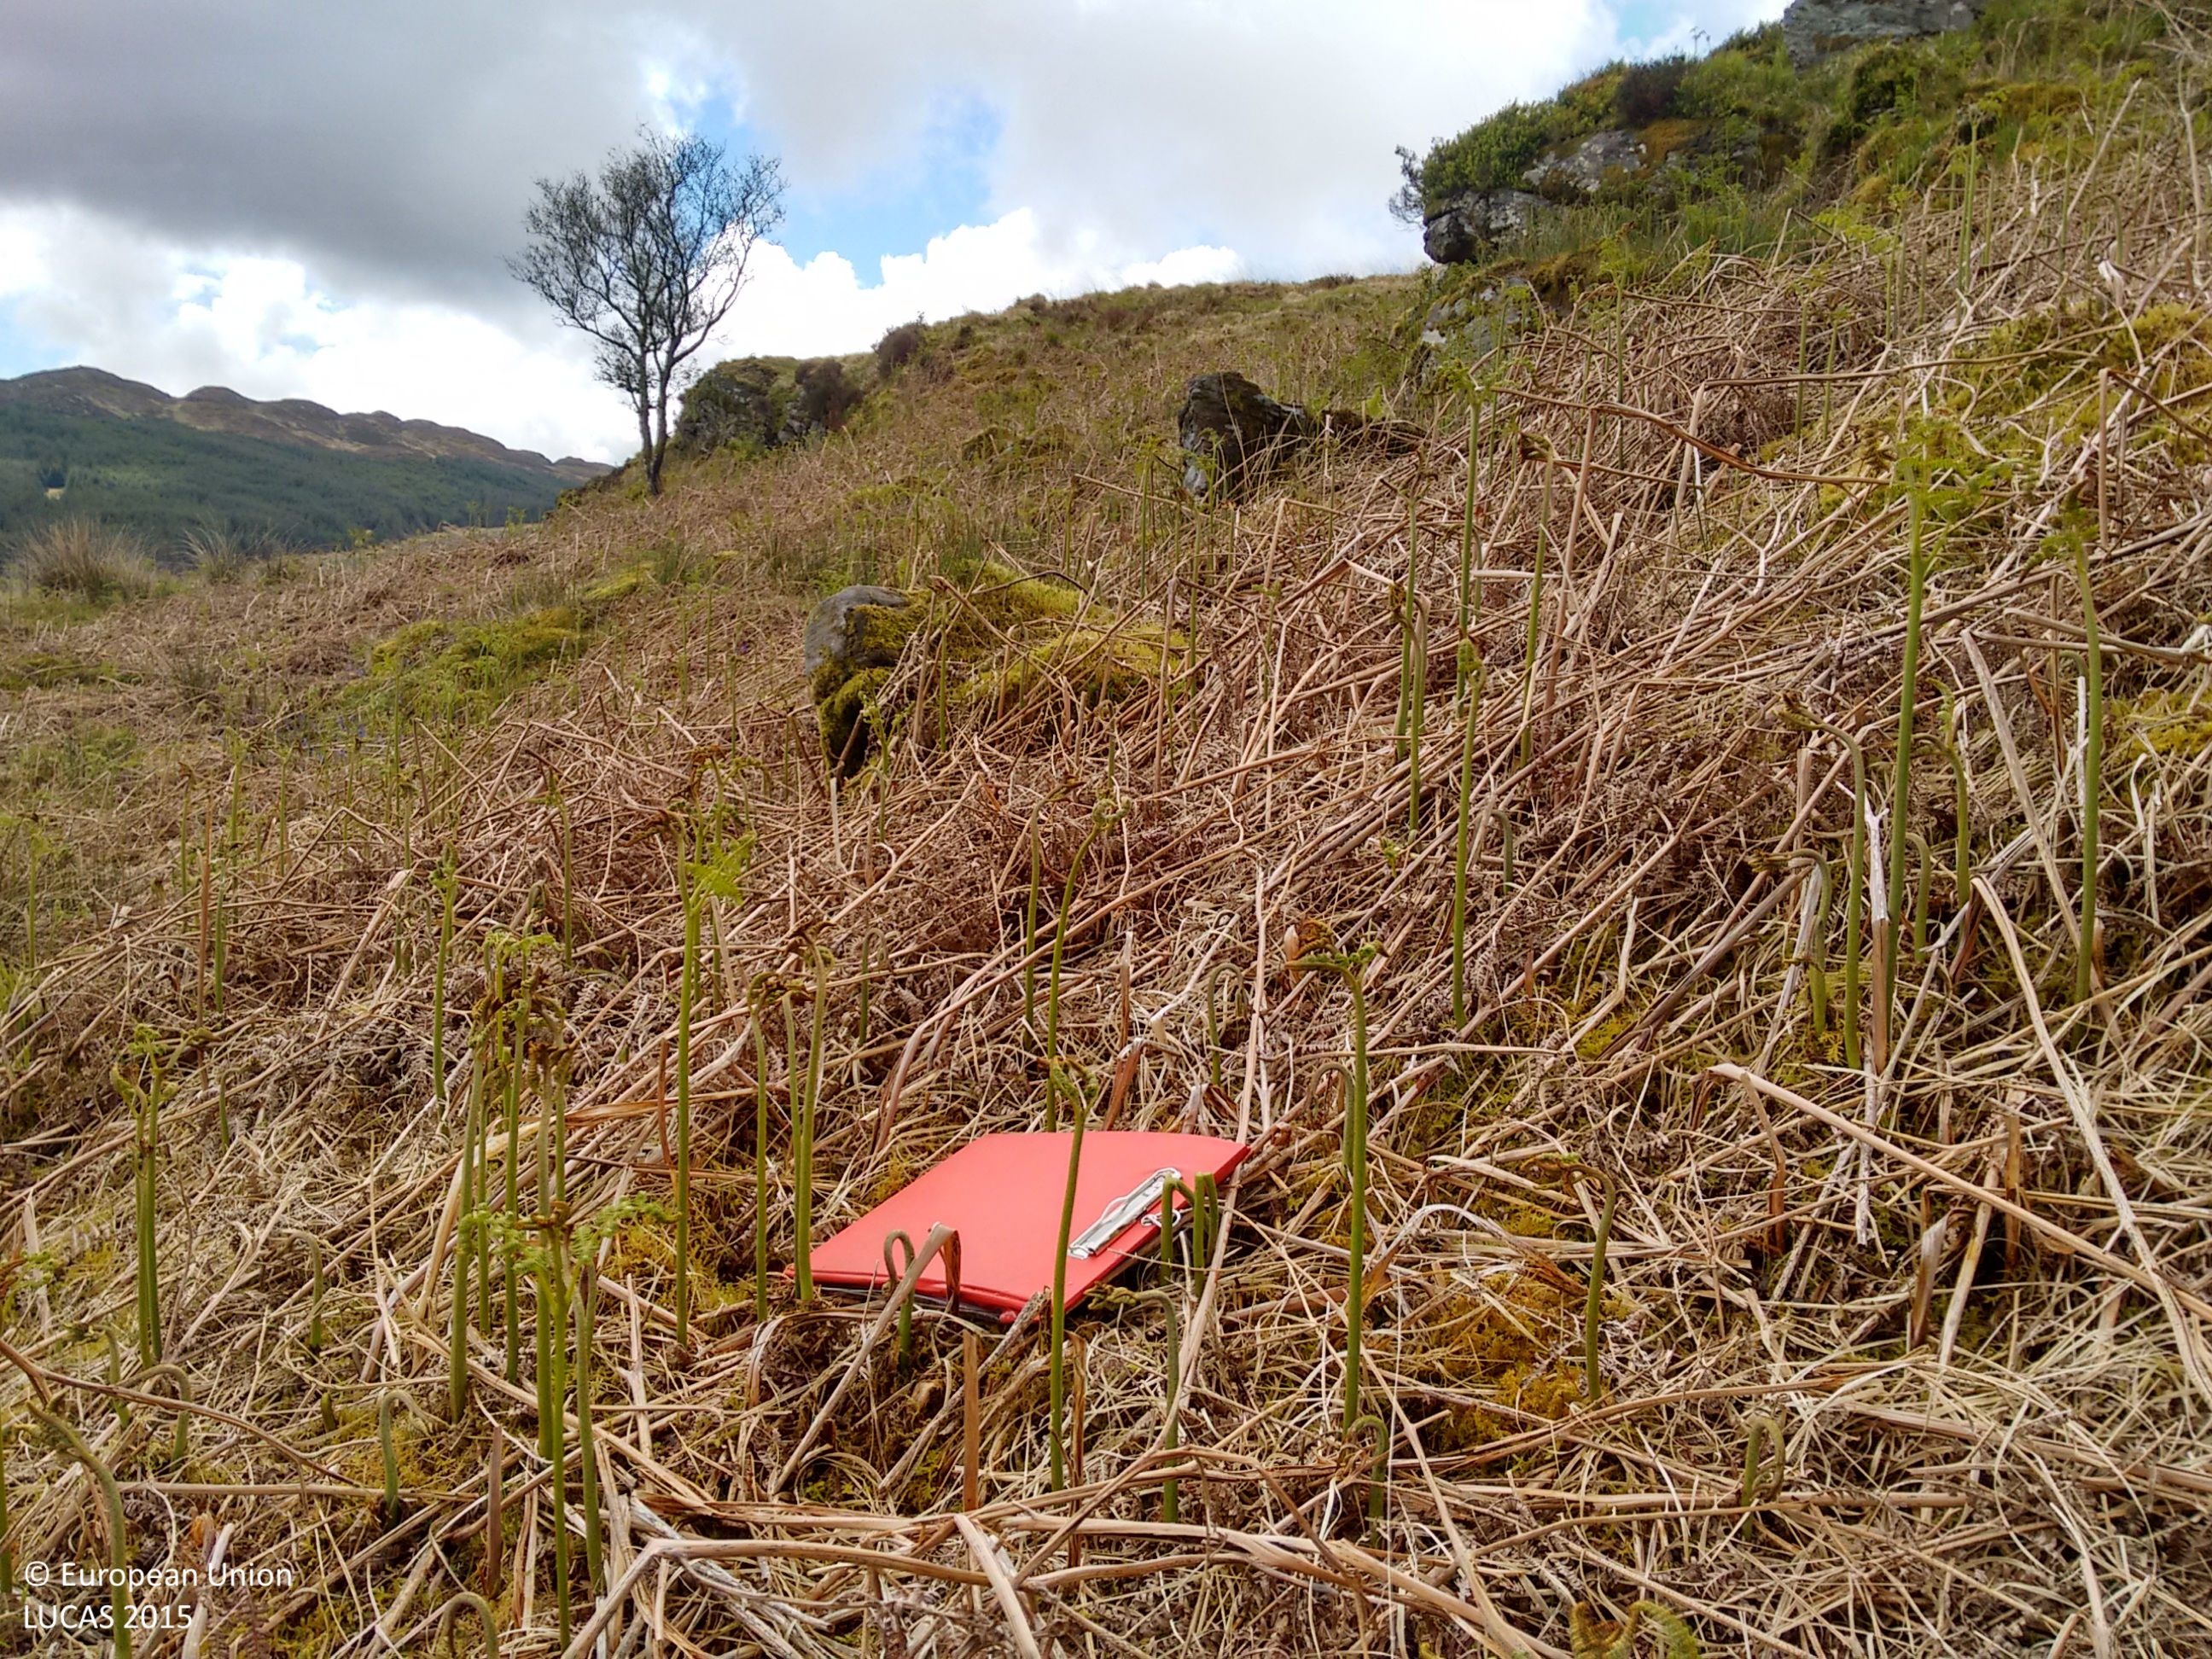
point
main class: Grassland
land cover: Grassland without tree/shrub cover
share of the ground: > 75 %
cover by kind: herbaceous plants 100 %
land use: Semi-natural and natural areas not in use
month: May
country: GB
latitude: 55.9972
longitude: -5.1367
